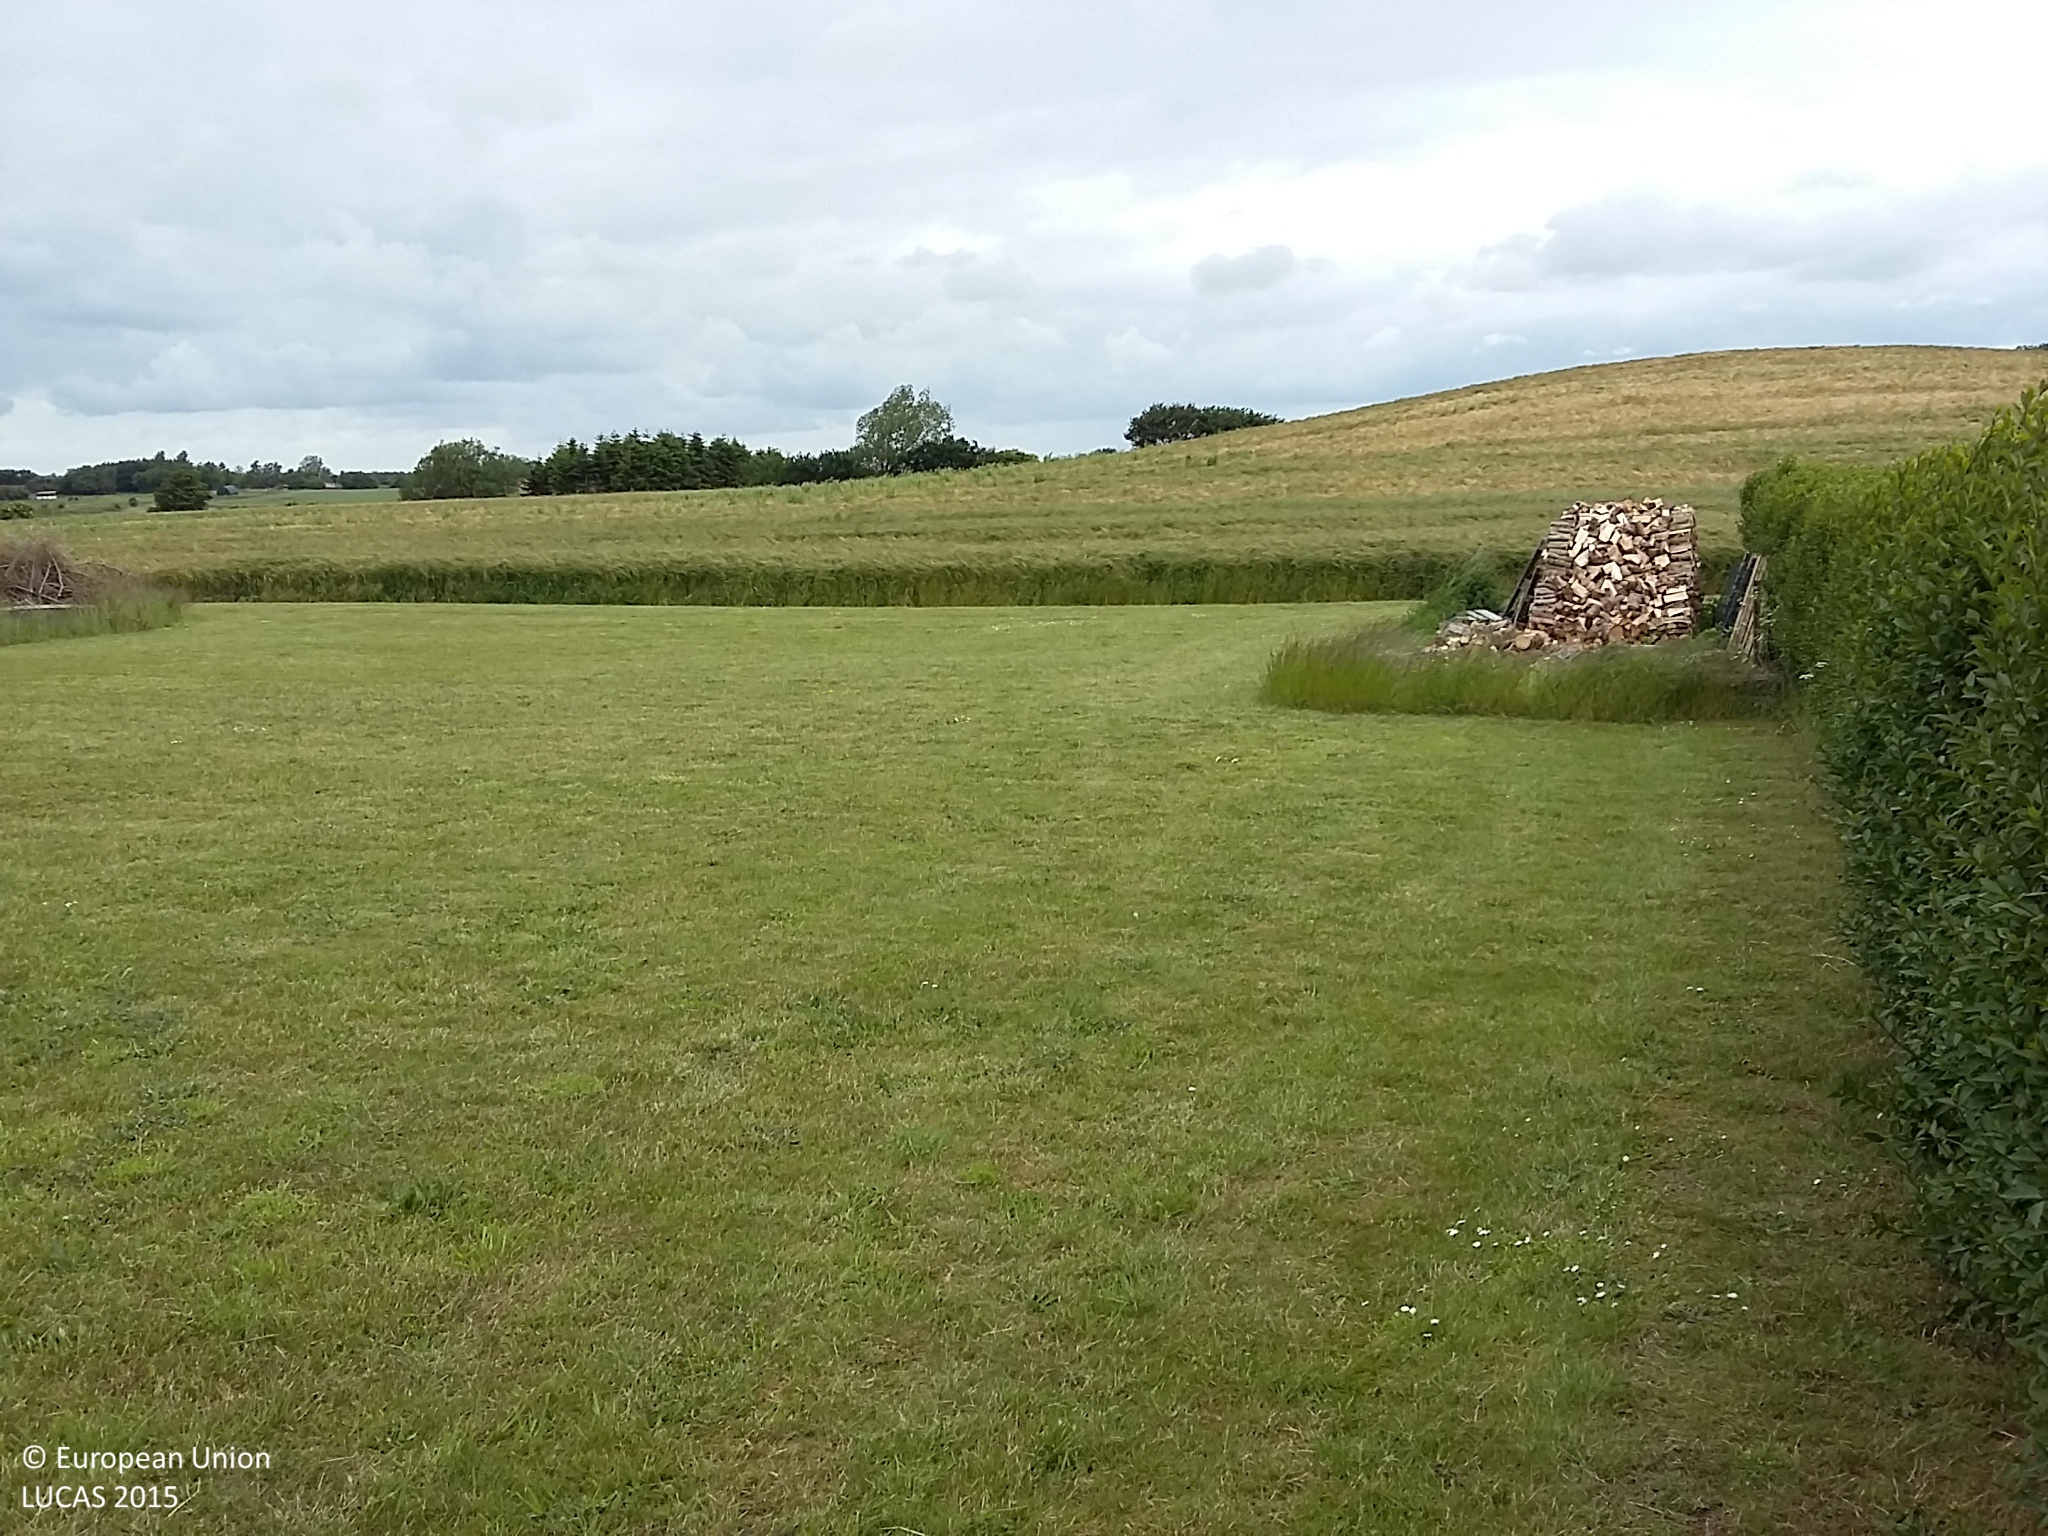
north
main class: Grassland
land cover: Grassland without tree/shrub cover
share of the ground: > 75 %
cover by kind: herbaceous plants 100 %
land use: Residential
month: June
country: DK
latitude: 54.8915
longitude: 10.7322
